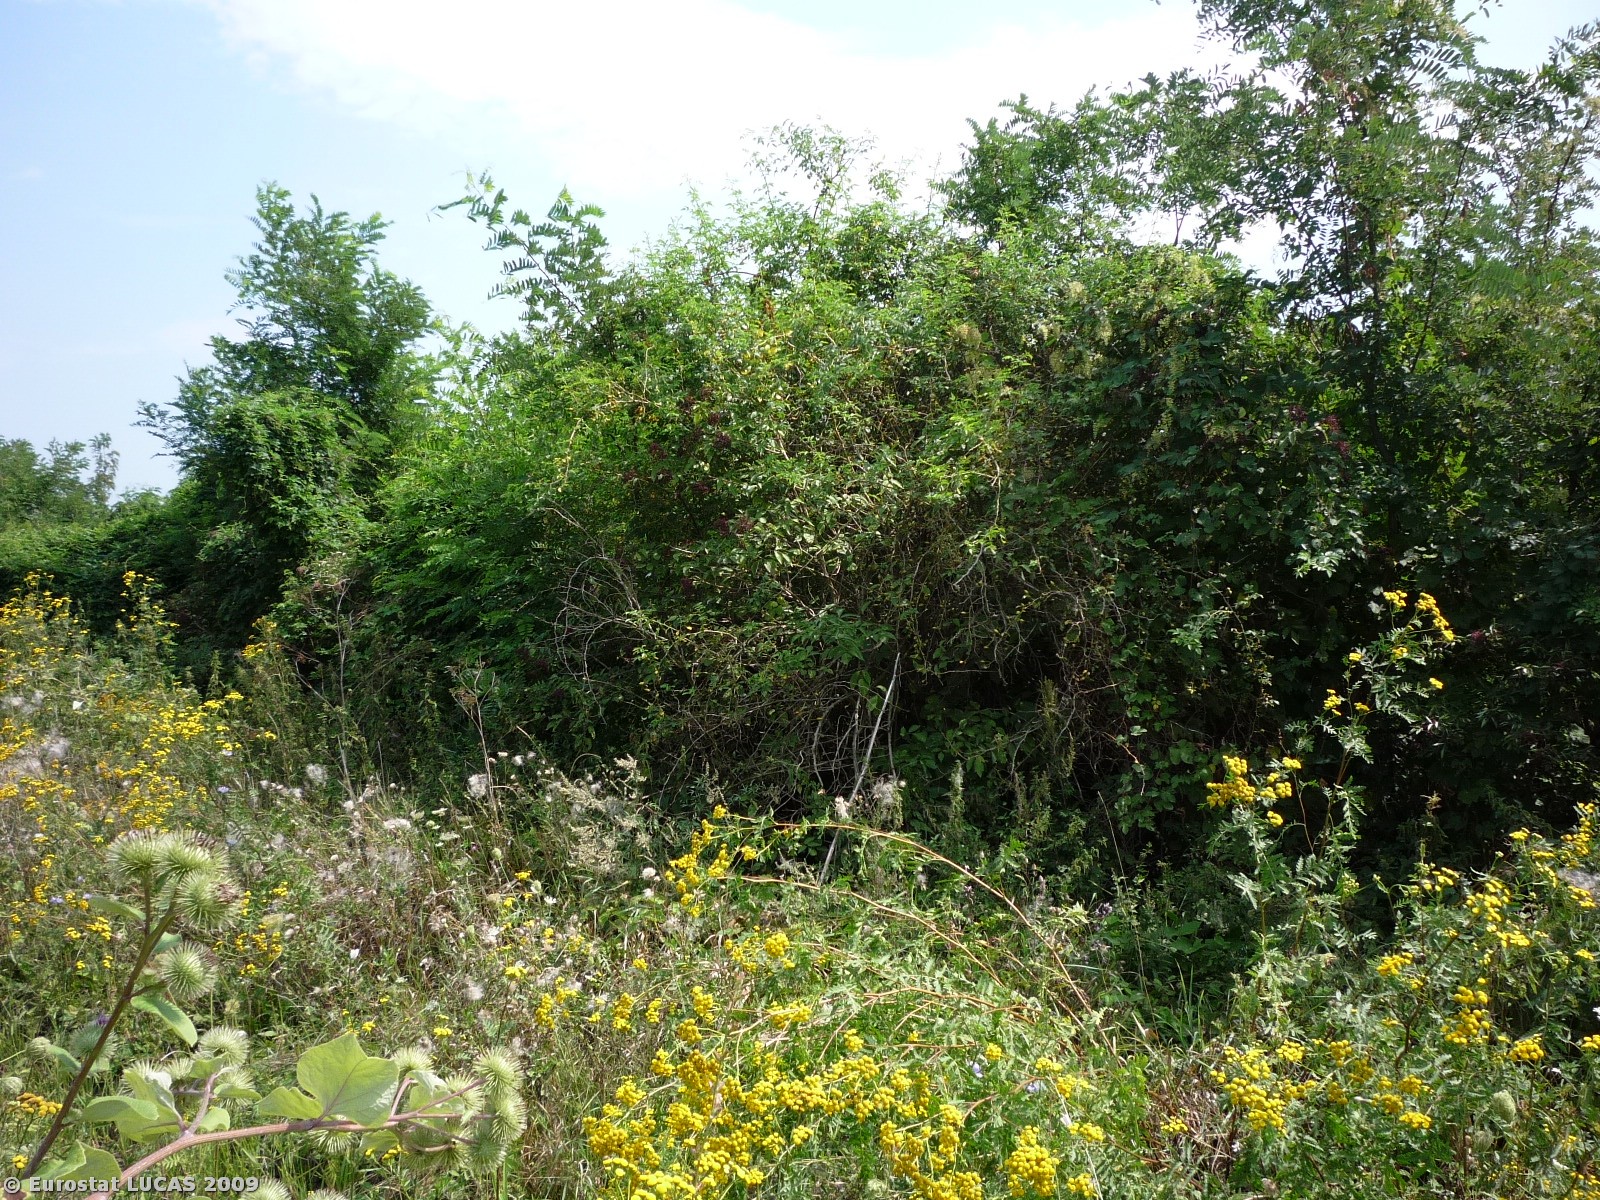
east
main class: Grassland
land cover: Spontaneously vegetated surfaces
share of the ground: > 75 %
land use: Fallow land
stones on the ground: < 10 %
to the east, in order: Spontaneously vegetated surfaces; Tracks; Shrubland without tree cover; Maize; Oats
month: August
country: HU
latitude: 48.2594
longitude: 21.9738
